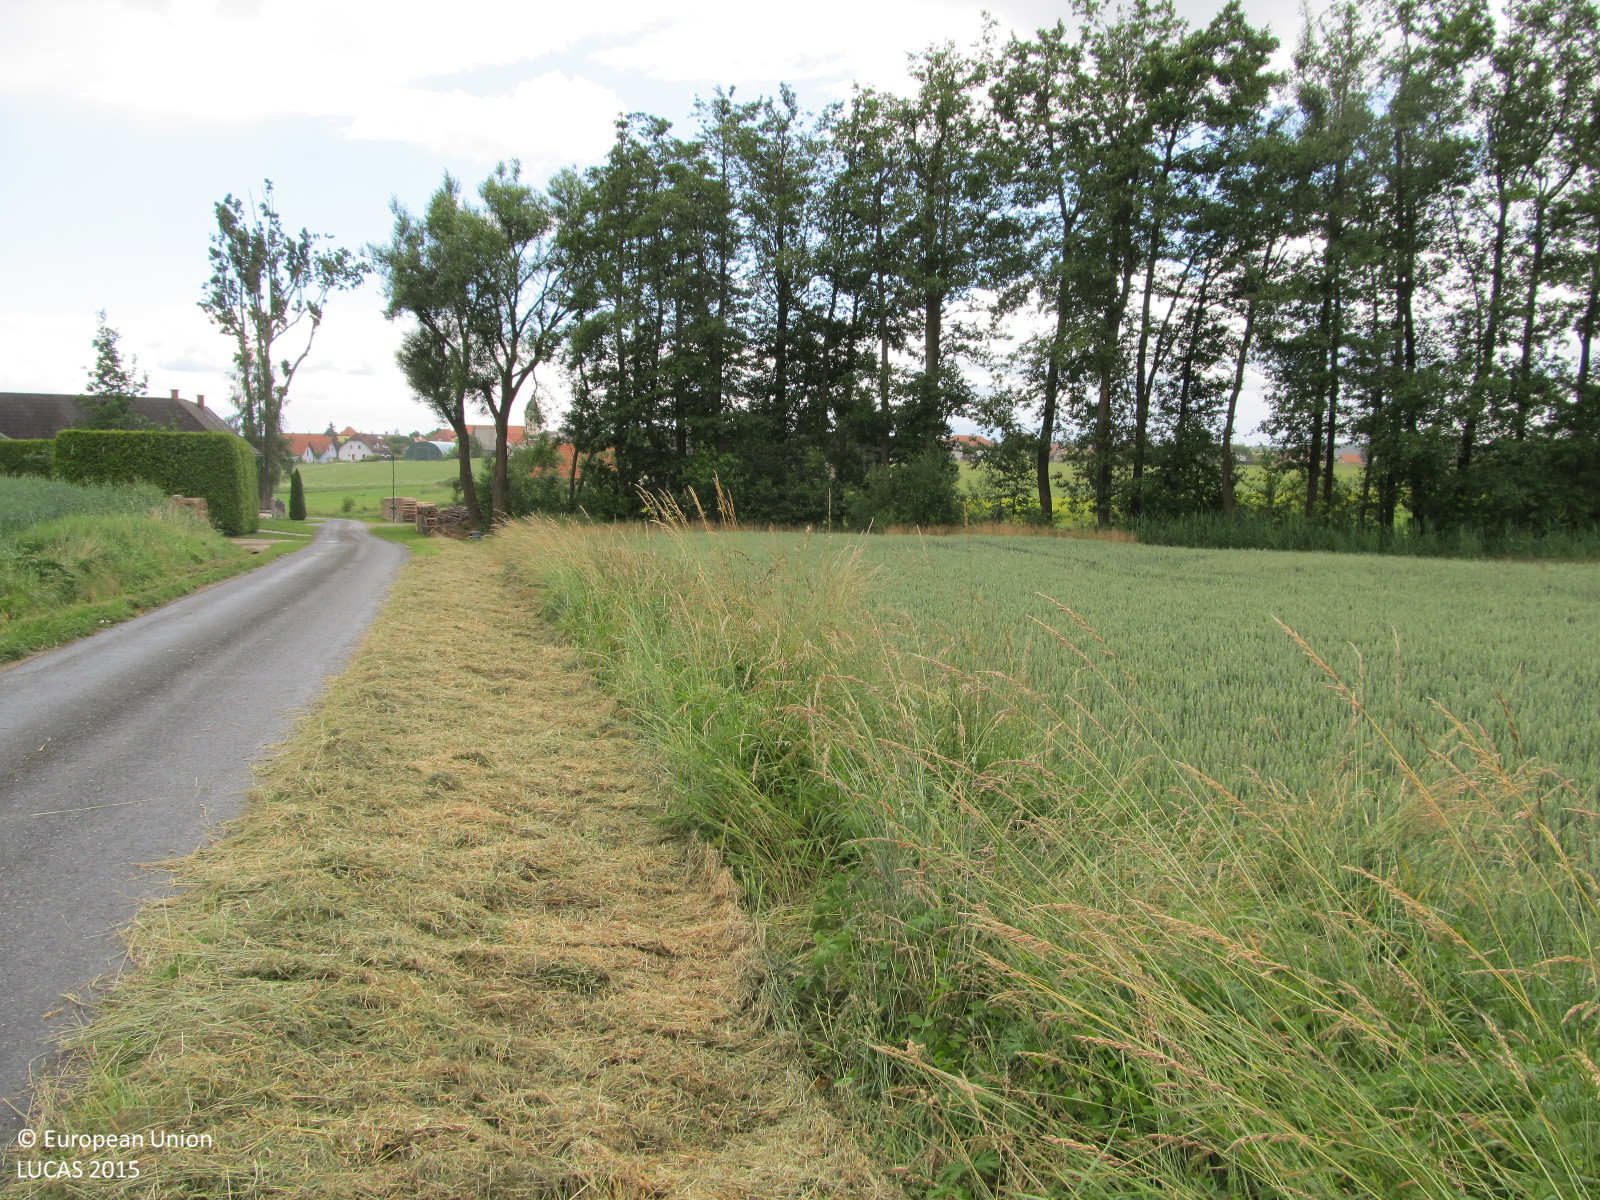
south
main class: Woodland
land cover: Broadleaved woodland
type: floodplain forest
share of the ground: > 75 %
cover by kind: broadleaved forest trees 80 %, shrubs 10 %, herbaceous plants 10 %
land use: Semi-natural and natural areas not in use
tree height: > 5 m
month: June
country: AT
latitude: 48.6480
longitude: 15.4457
